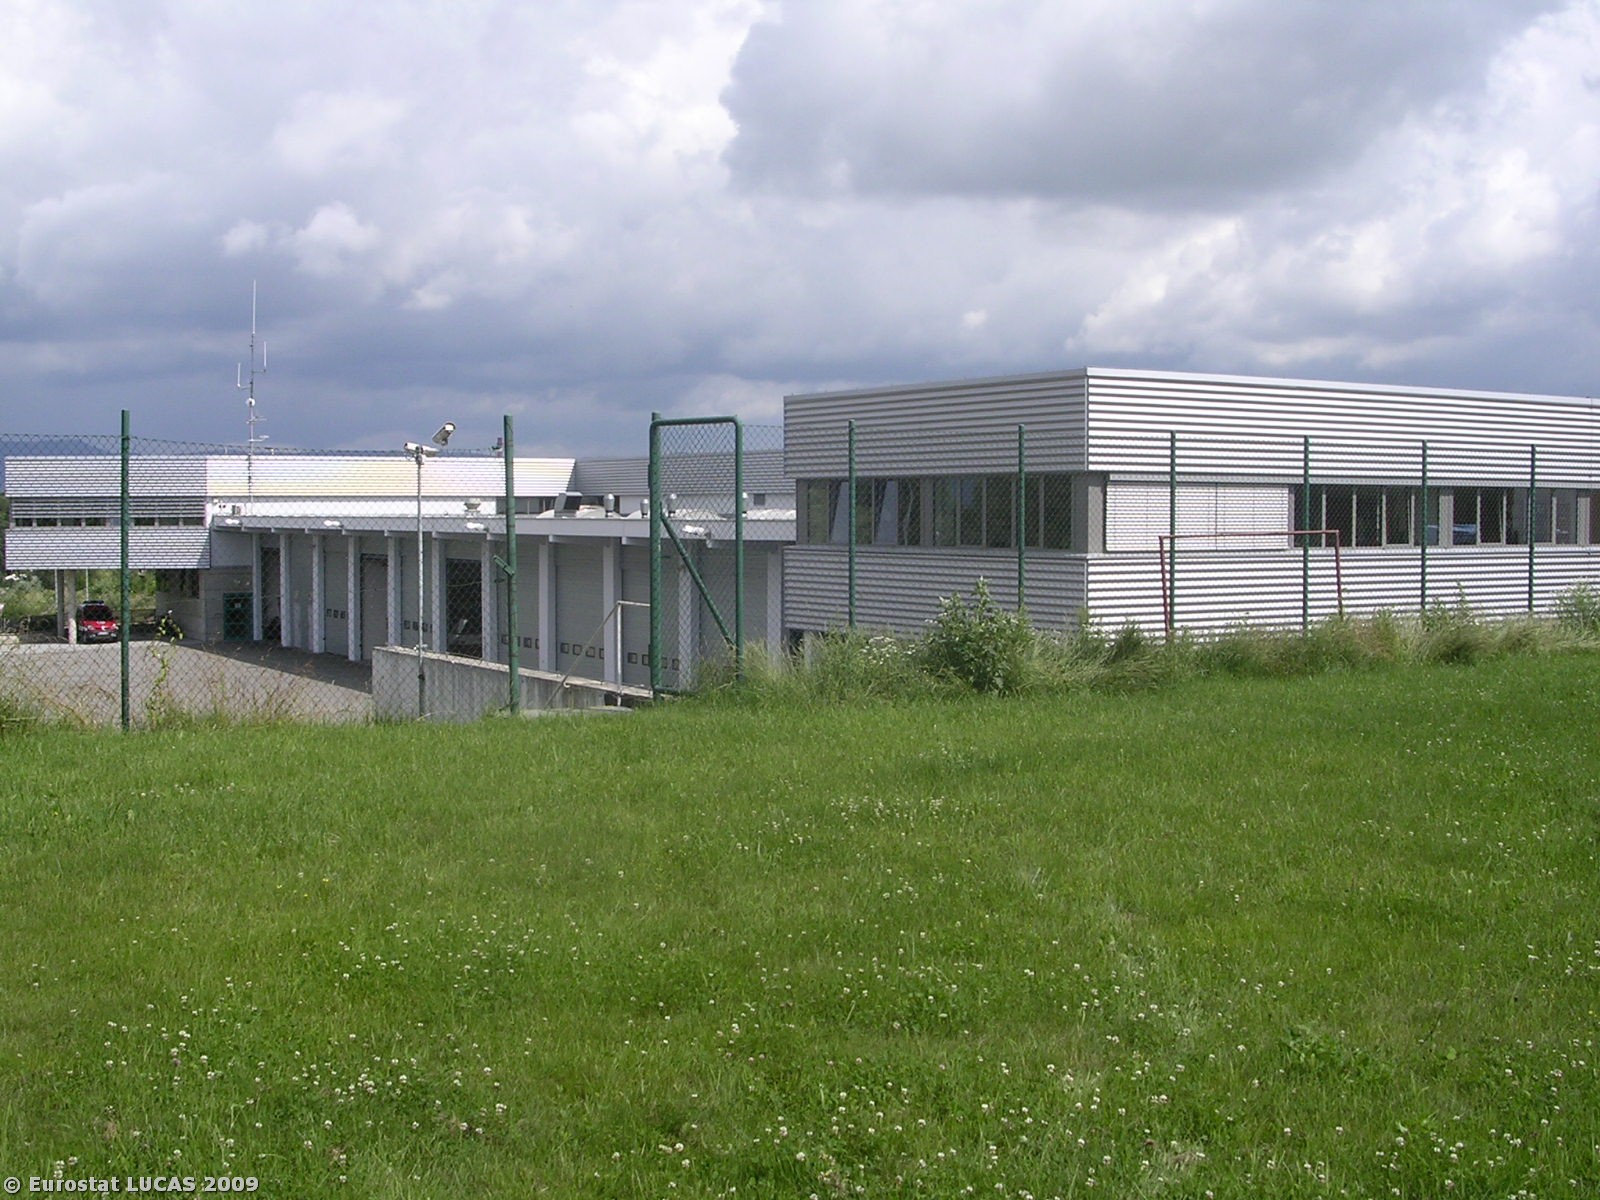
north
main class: Grassland
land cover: Grassland without tree/shrub cover
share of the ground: > 75 %
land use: Community services
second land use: Sport
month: July
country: CZ
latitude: 50.6700
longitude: 14.5438
